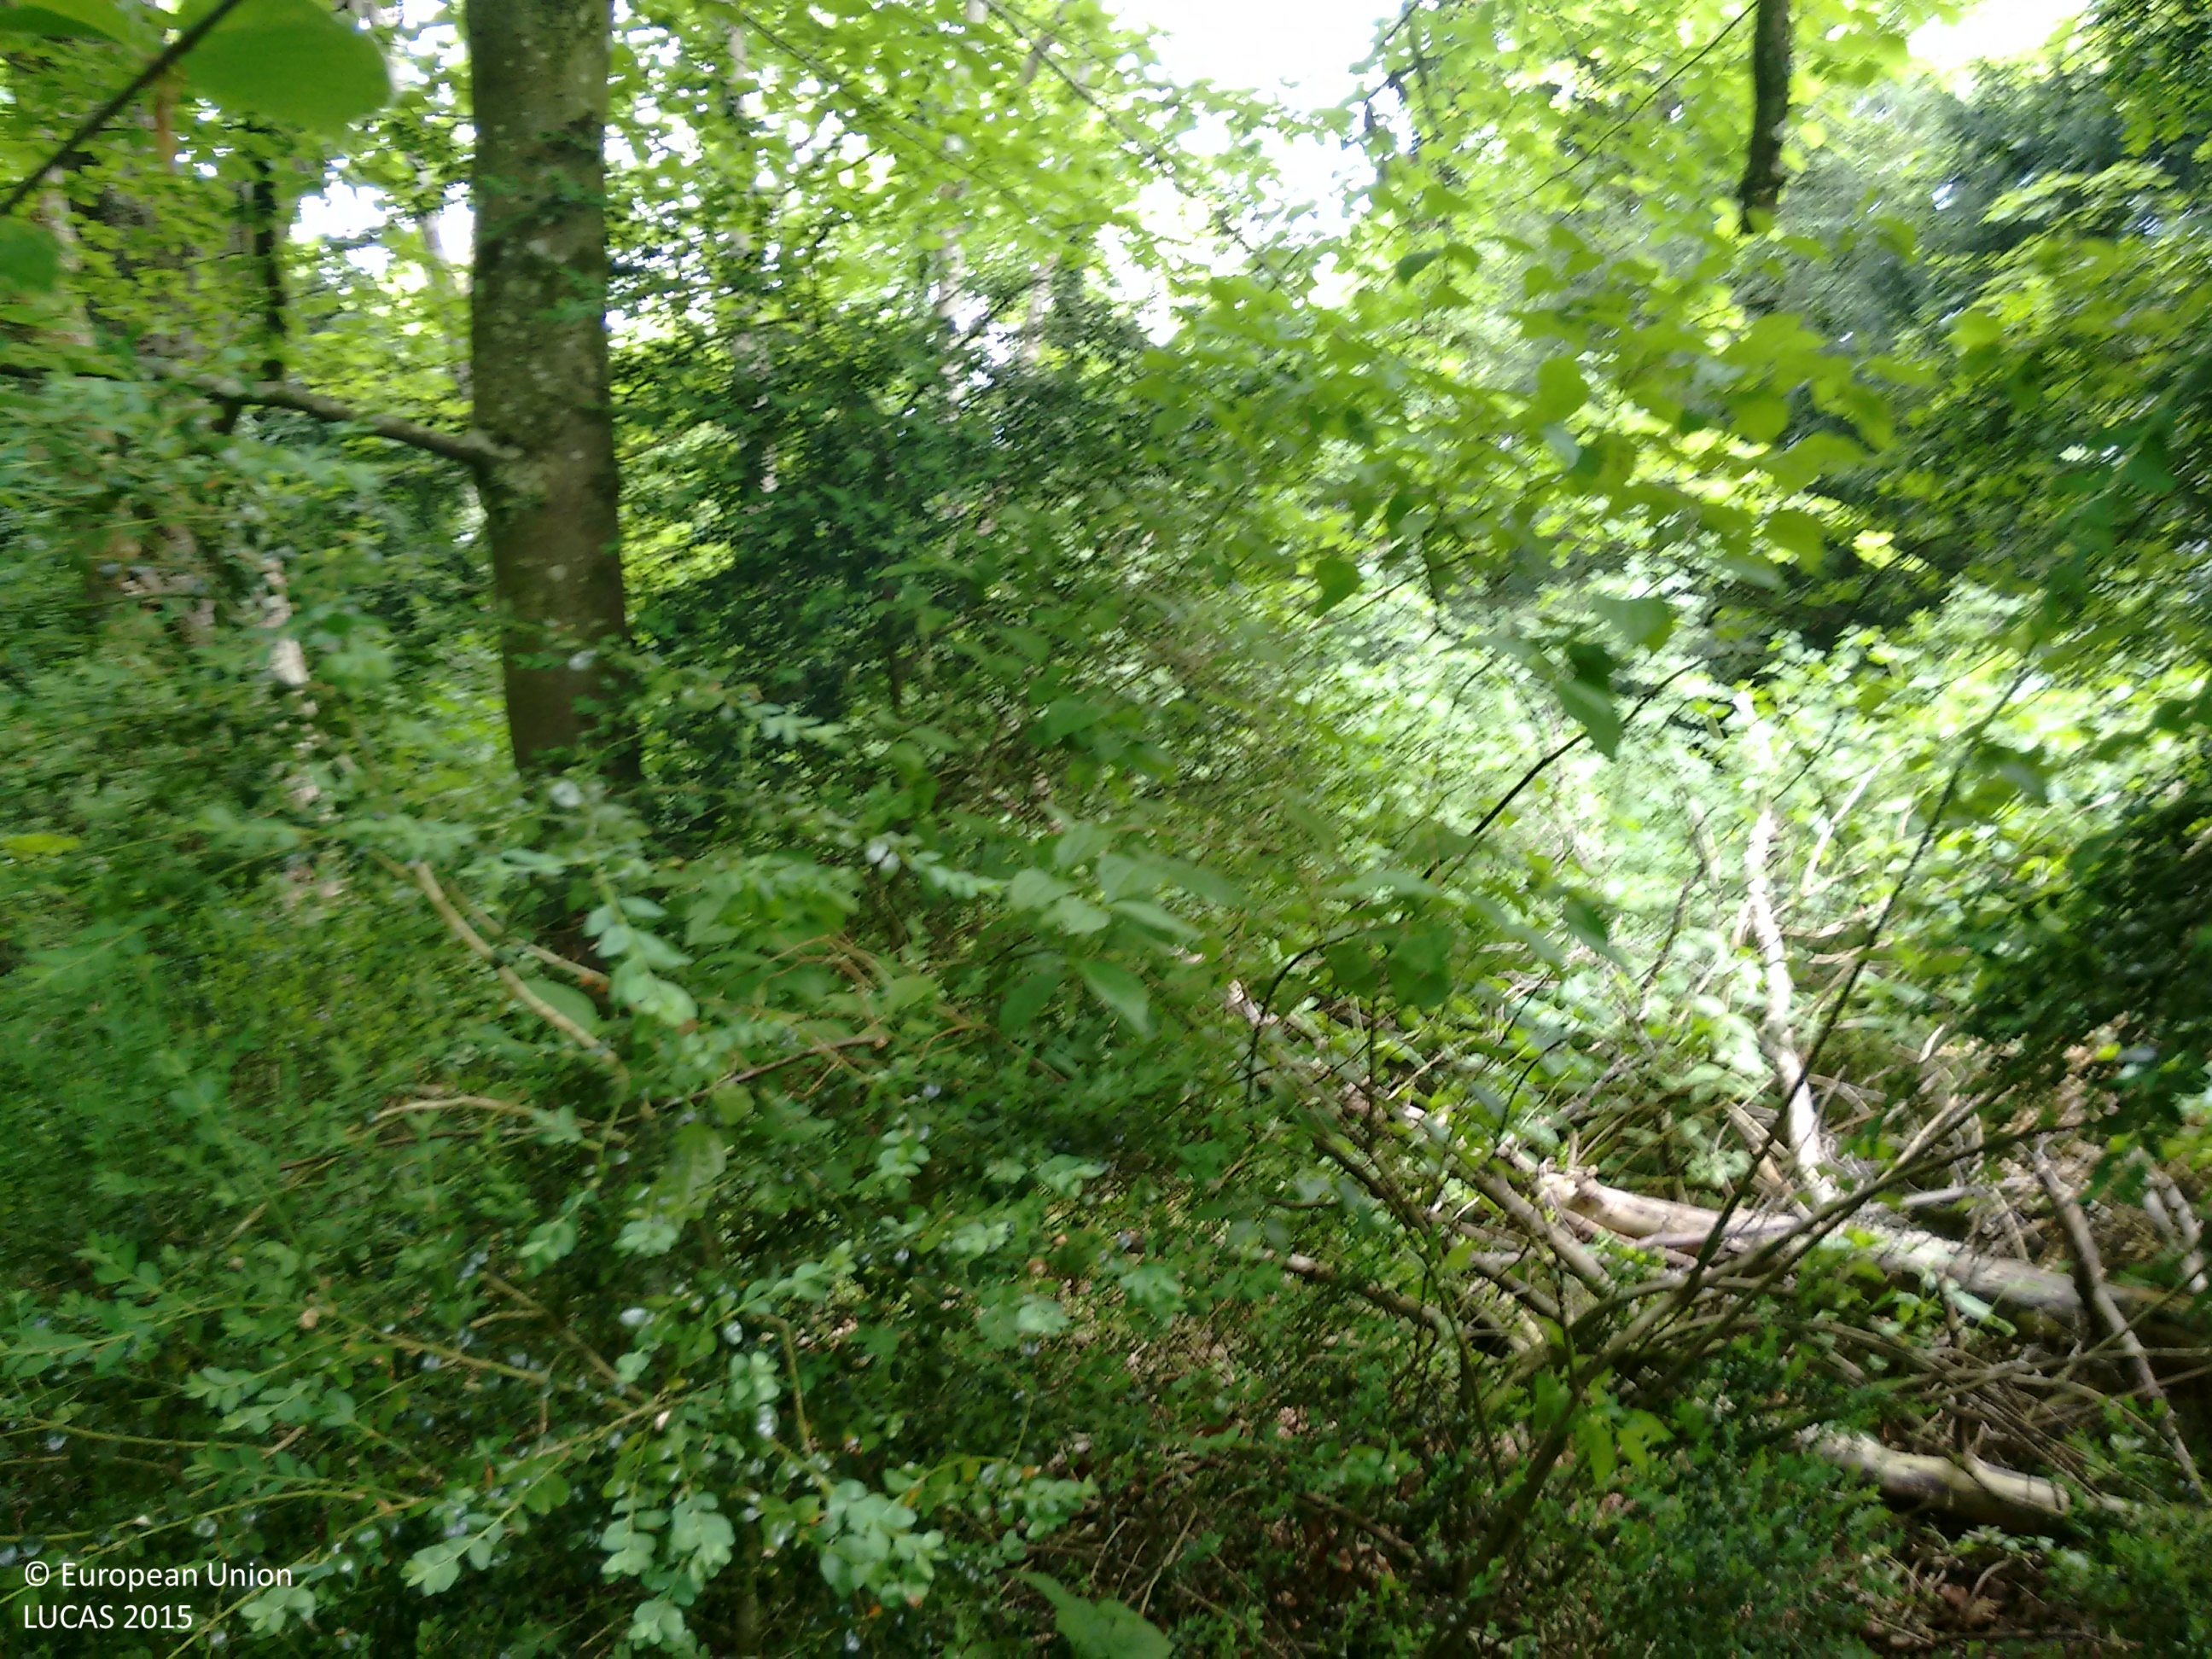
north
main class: Woodland
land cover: Broadleaved woodland
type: beech forest
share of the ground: > 75 %
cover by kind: broadleaved forest trees 95 %, herbaceous plants 5 %
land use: Semi-natural and natural areas not in use
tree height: > 5 m
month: May
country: GB
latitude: 50.8563
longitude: -2.1785
